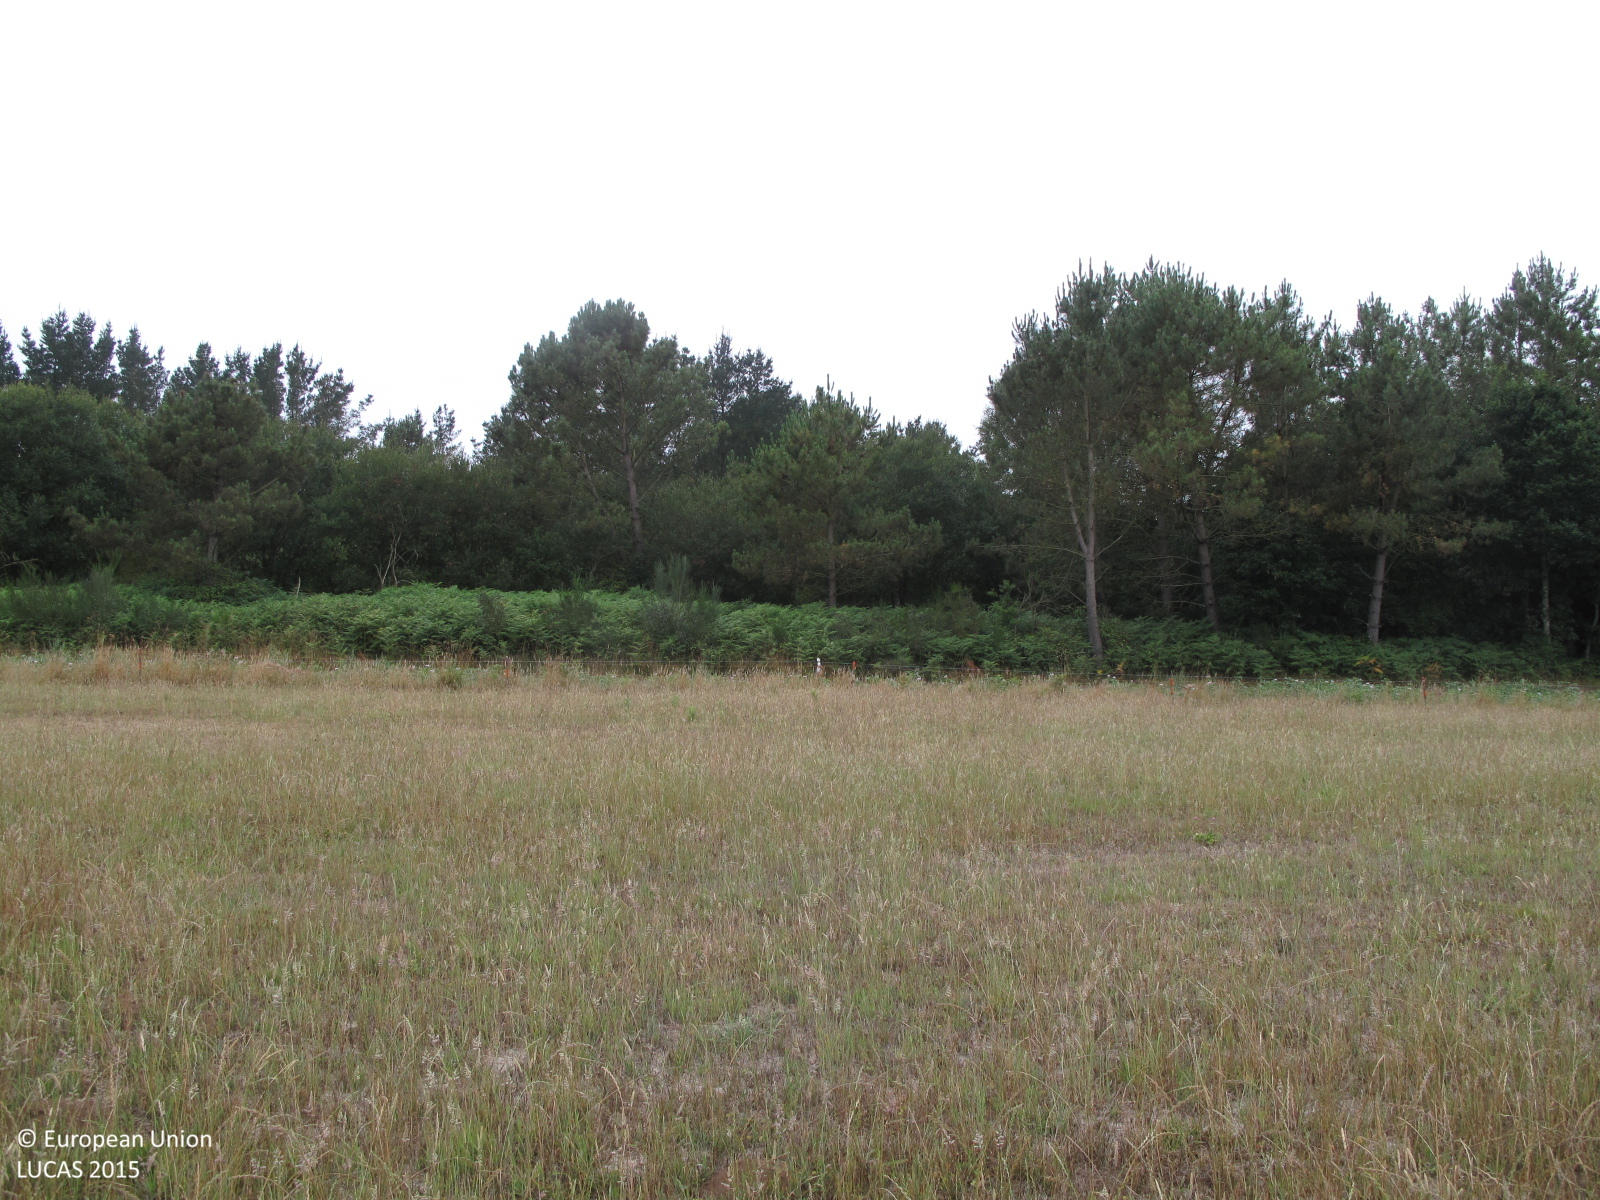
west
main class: Grassland
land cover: Grassland without tree/shrub cover
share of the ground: > 75 %
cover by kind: herbaceous plants 100 %
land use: Agriculture (excluding fallow land and kitchen gardens)
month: July
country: ES
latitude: 43.1769
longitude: -7.9406
